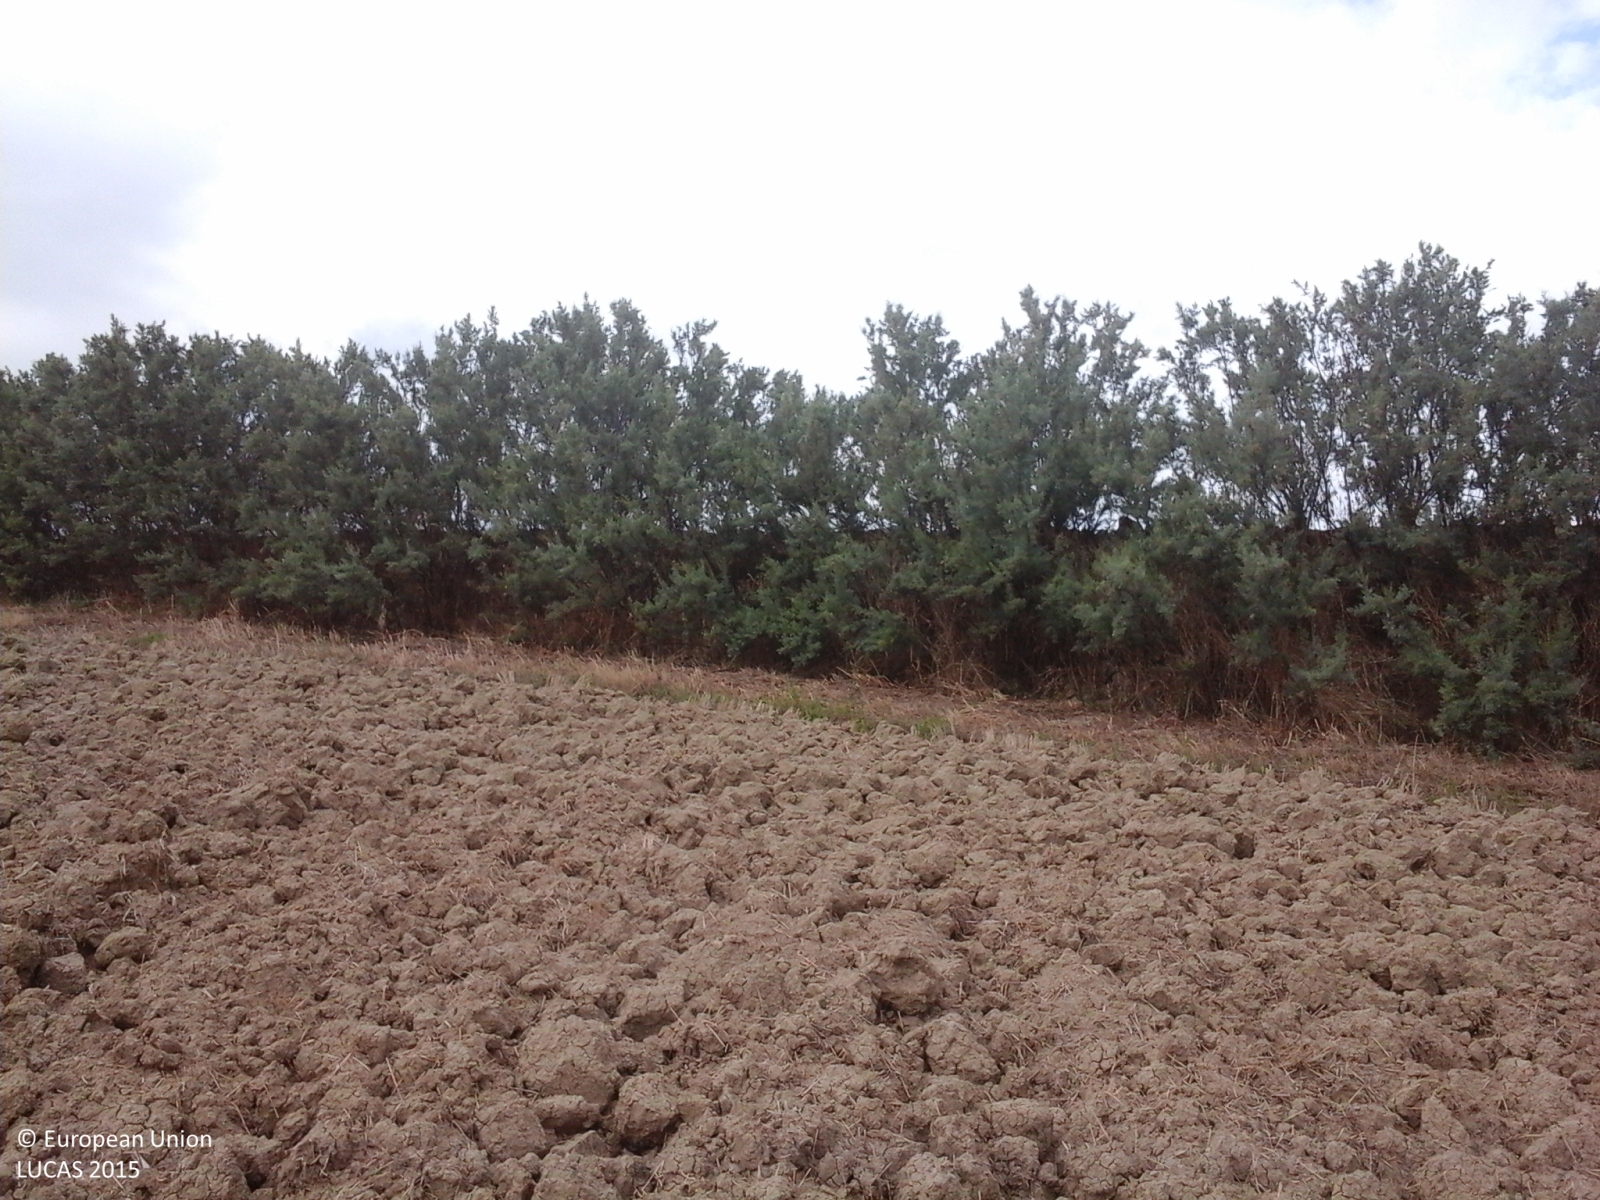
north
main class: Cropland
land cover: Durum wheat
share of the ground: < 10 %
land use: Agriculture (excluding fallow land and kitchen gardens)
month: August
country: IT
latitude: 43.4866
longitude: 13.2685
